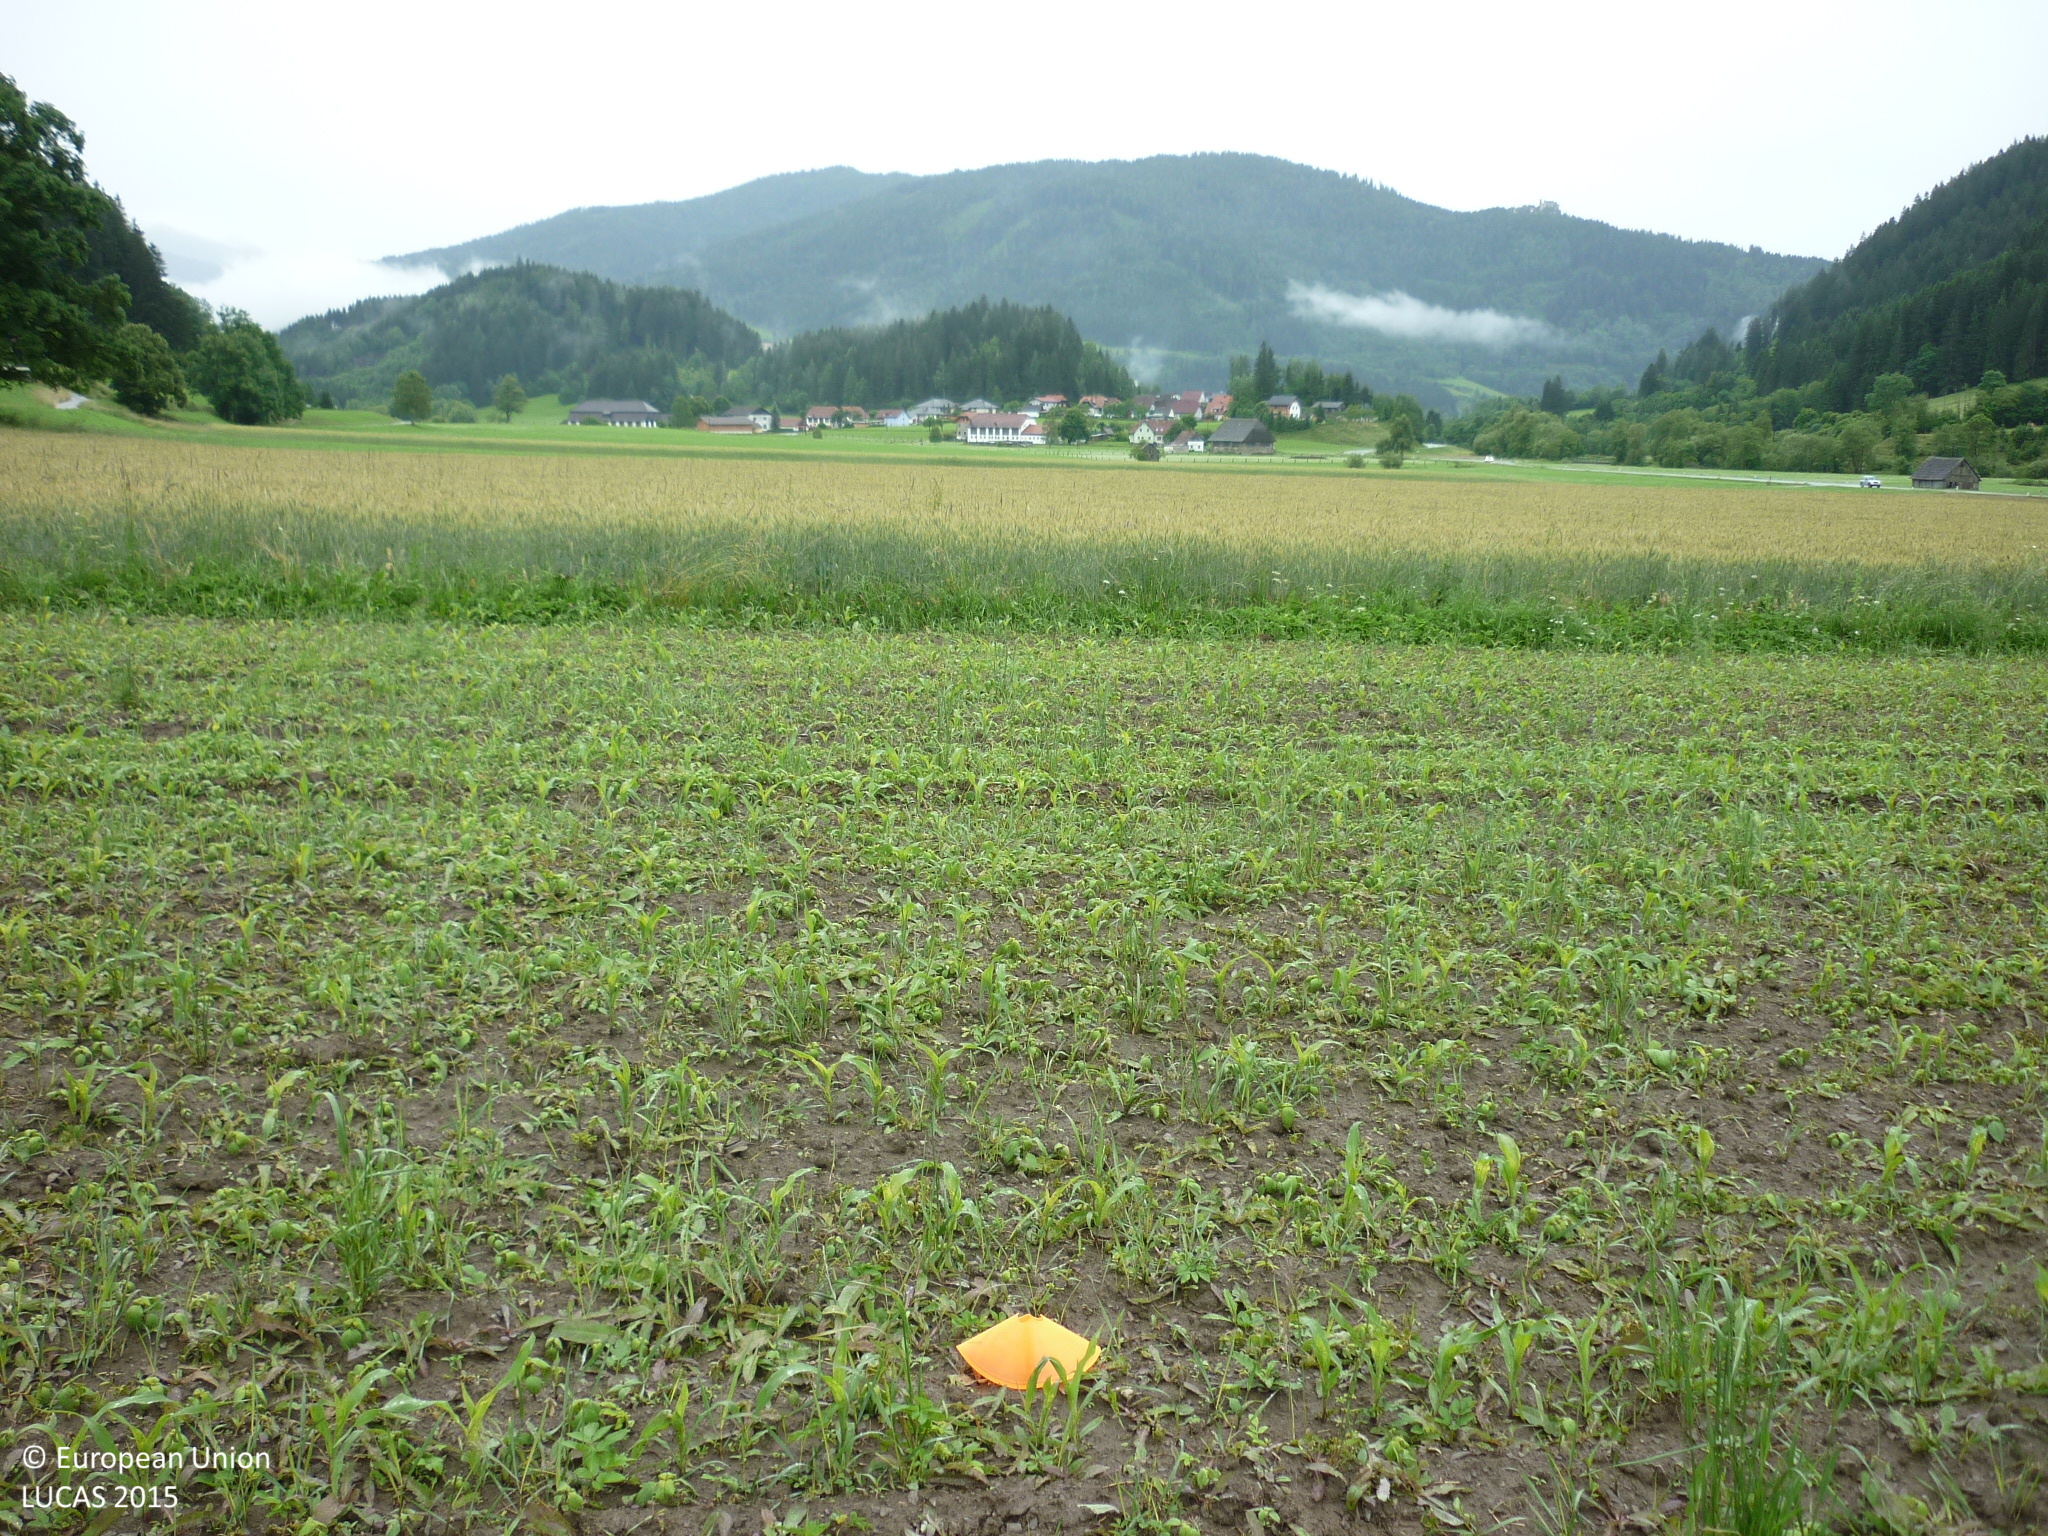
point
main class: Cropland
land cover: Maize
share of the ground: 25 - 50 %
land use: Agriculture (excluding fallow land and kitchen gardens)
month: June
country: AT
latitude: 47.1638
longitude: 14.3648
